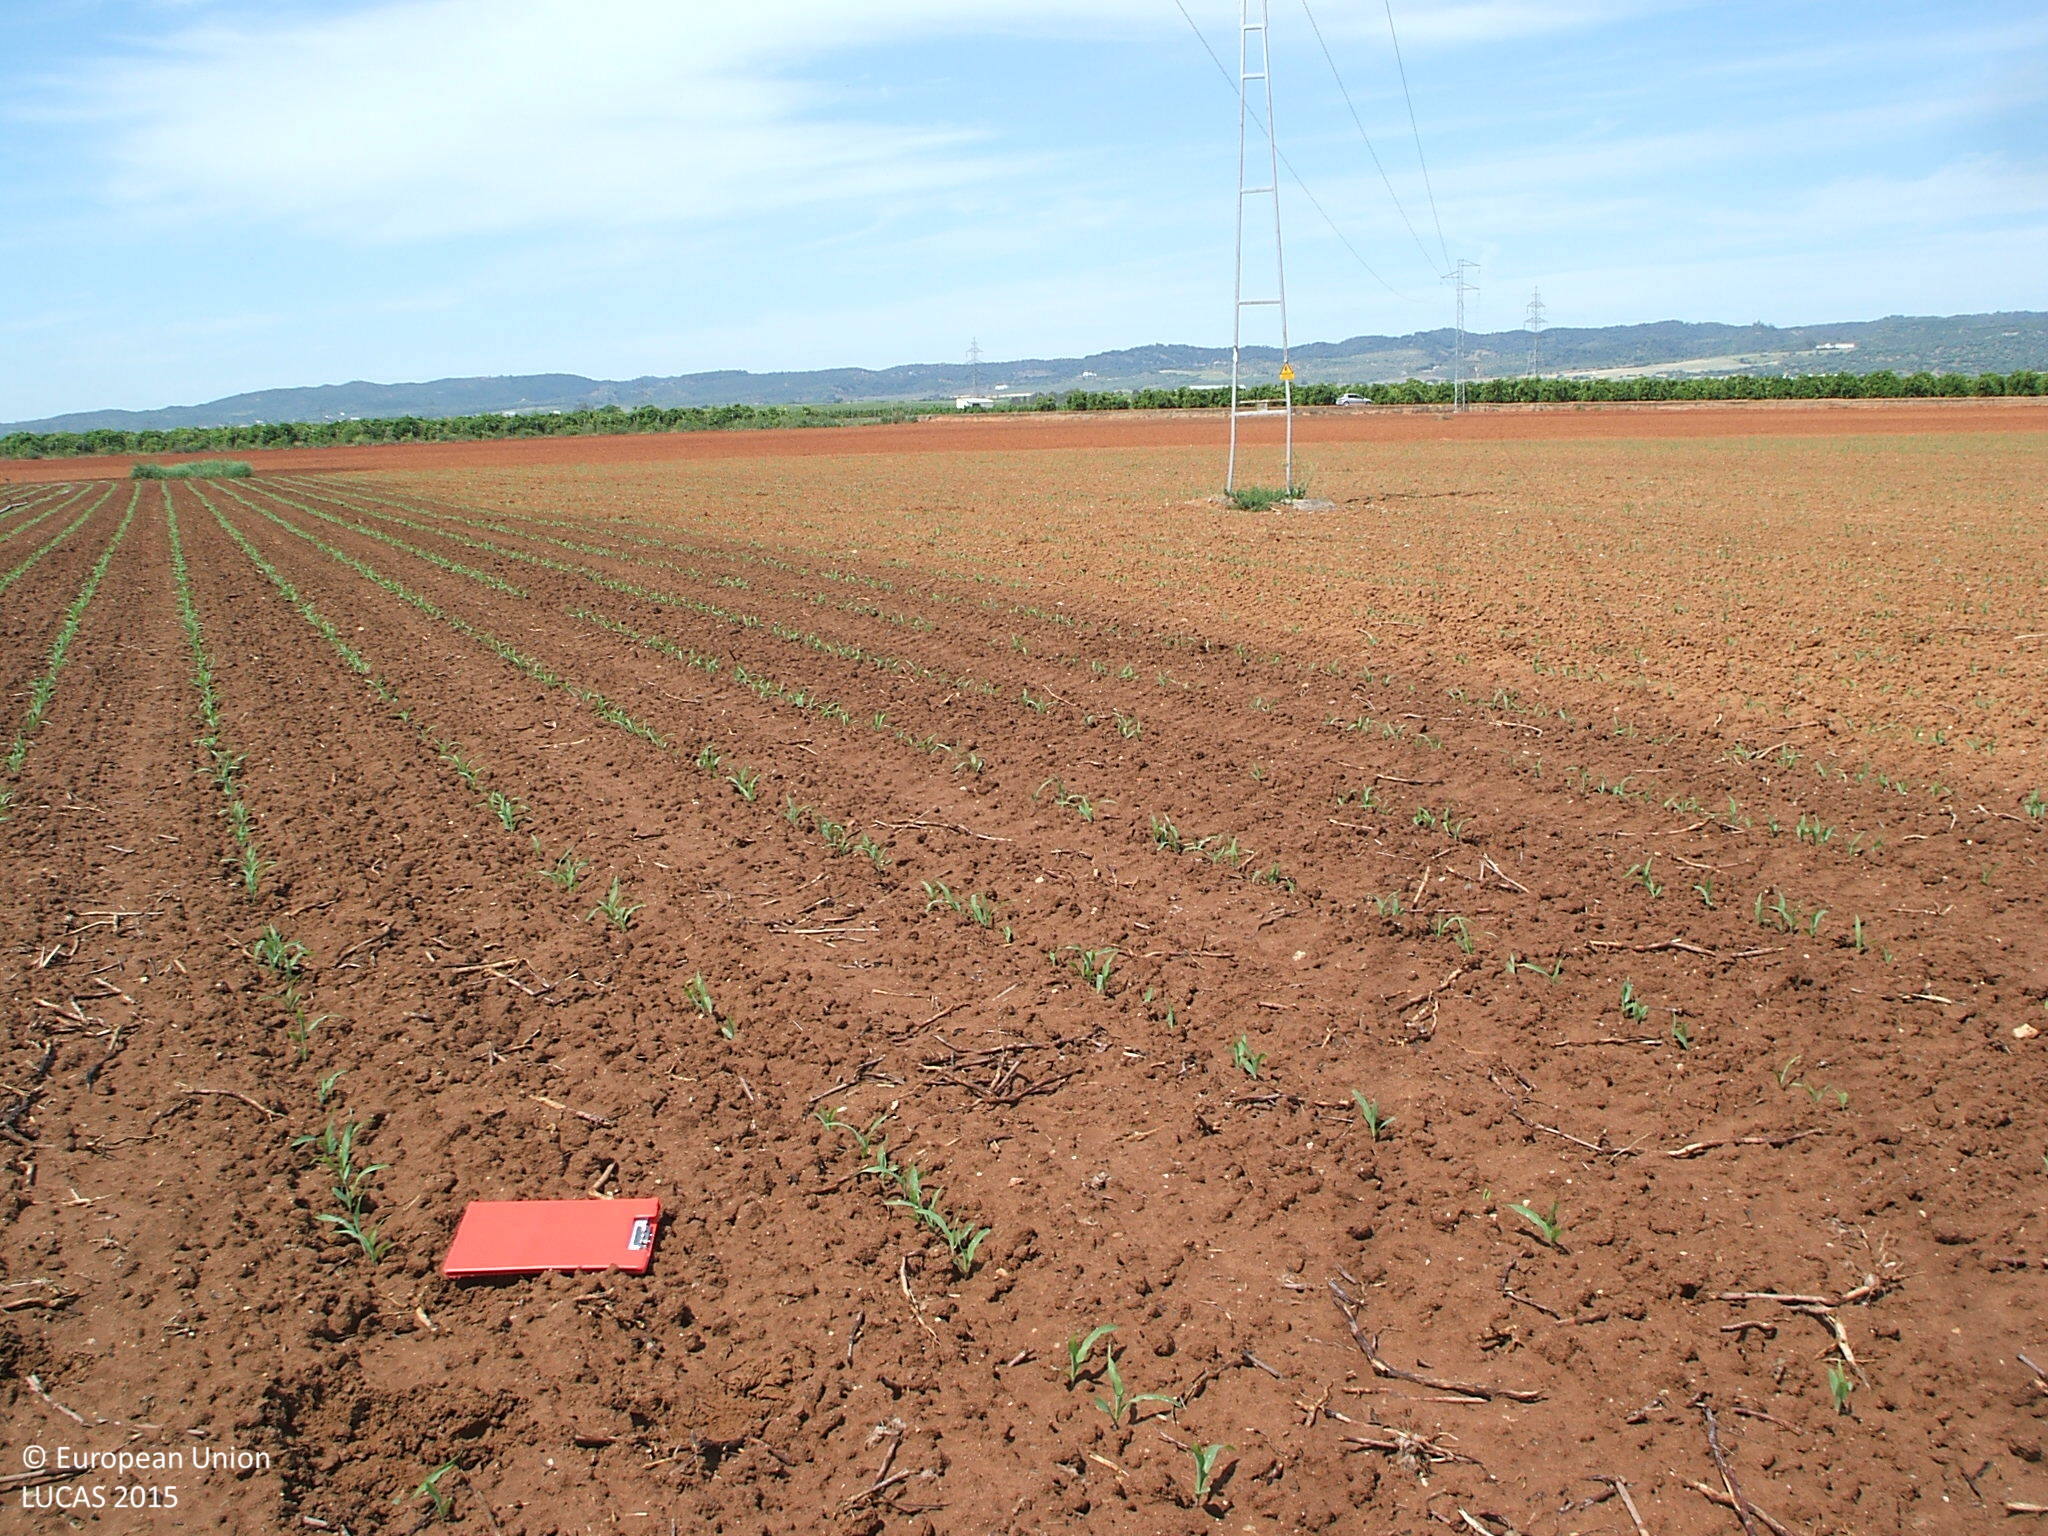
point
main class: Artificial land
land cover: Other artificial areas
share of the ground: < 10 %
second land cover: Maize
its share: < 10 %
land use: Electricity, gas and thermal power distribution
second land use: Agriculture (excluding fallow land and kitchen gardens)
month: April
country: ES
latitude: 37.6913
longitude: -5.4552
